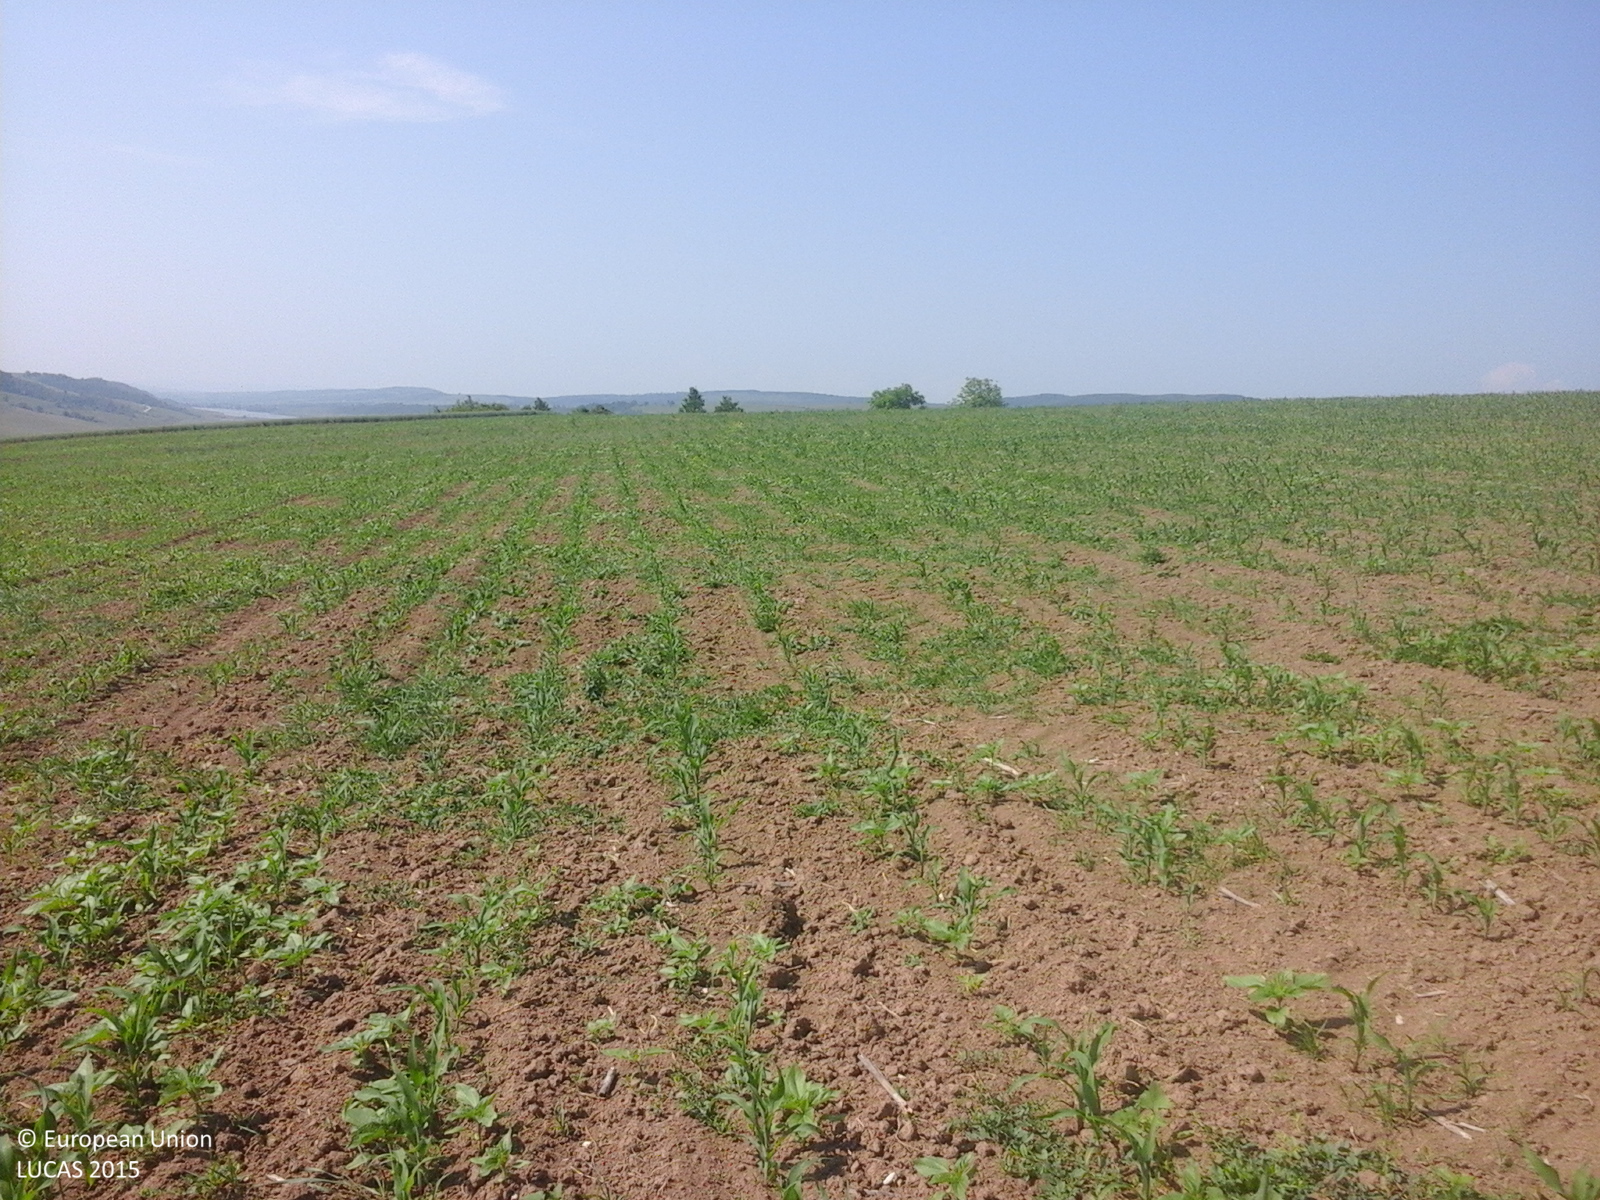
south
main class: Cropland
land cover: Maize
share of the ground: 10 - 25 %
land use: Agriculture (excluding fallow land and kitchen gardens)
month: June
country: RO
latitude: 46.5793
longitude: 27.1026
